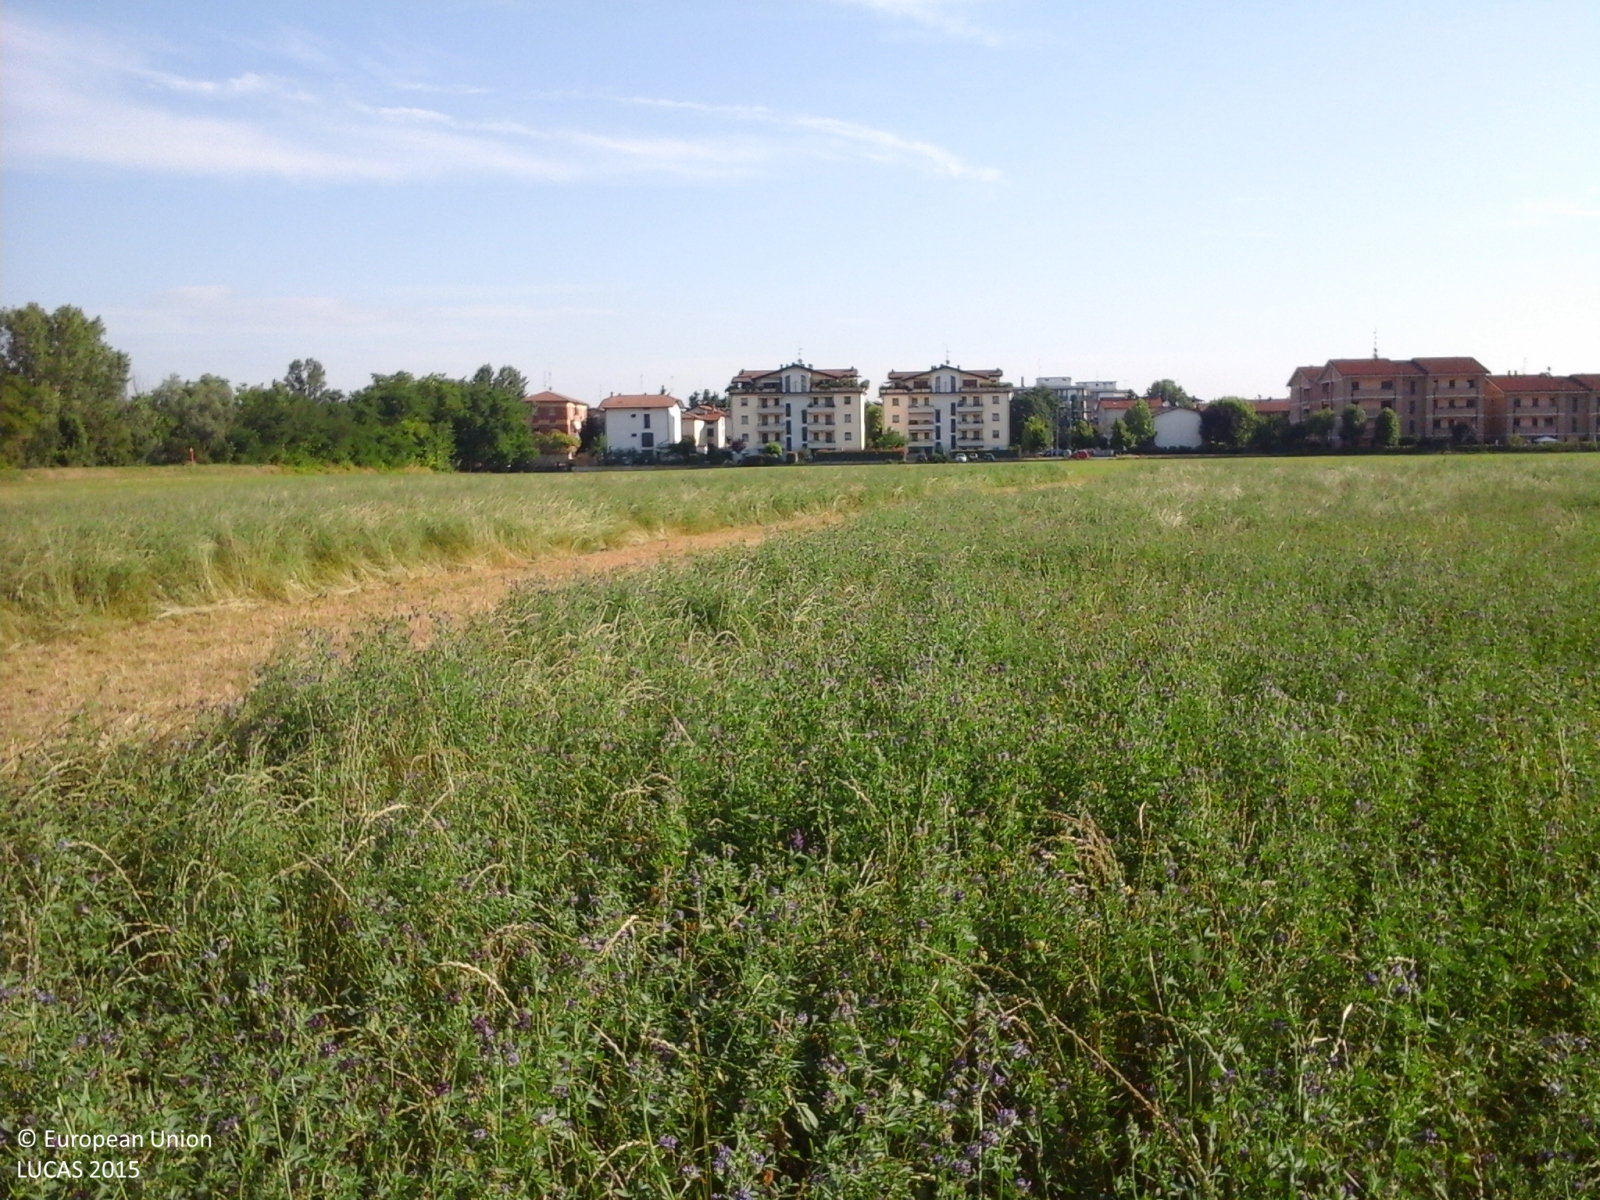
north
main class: Cropland
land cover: Lucerne
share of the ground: > 75 %
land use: Agriculture (excluding fallow land and kitchen gardens)
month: June
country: IT
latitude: 44.6915
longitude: 10.5918
